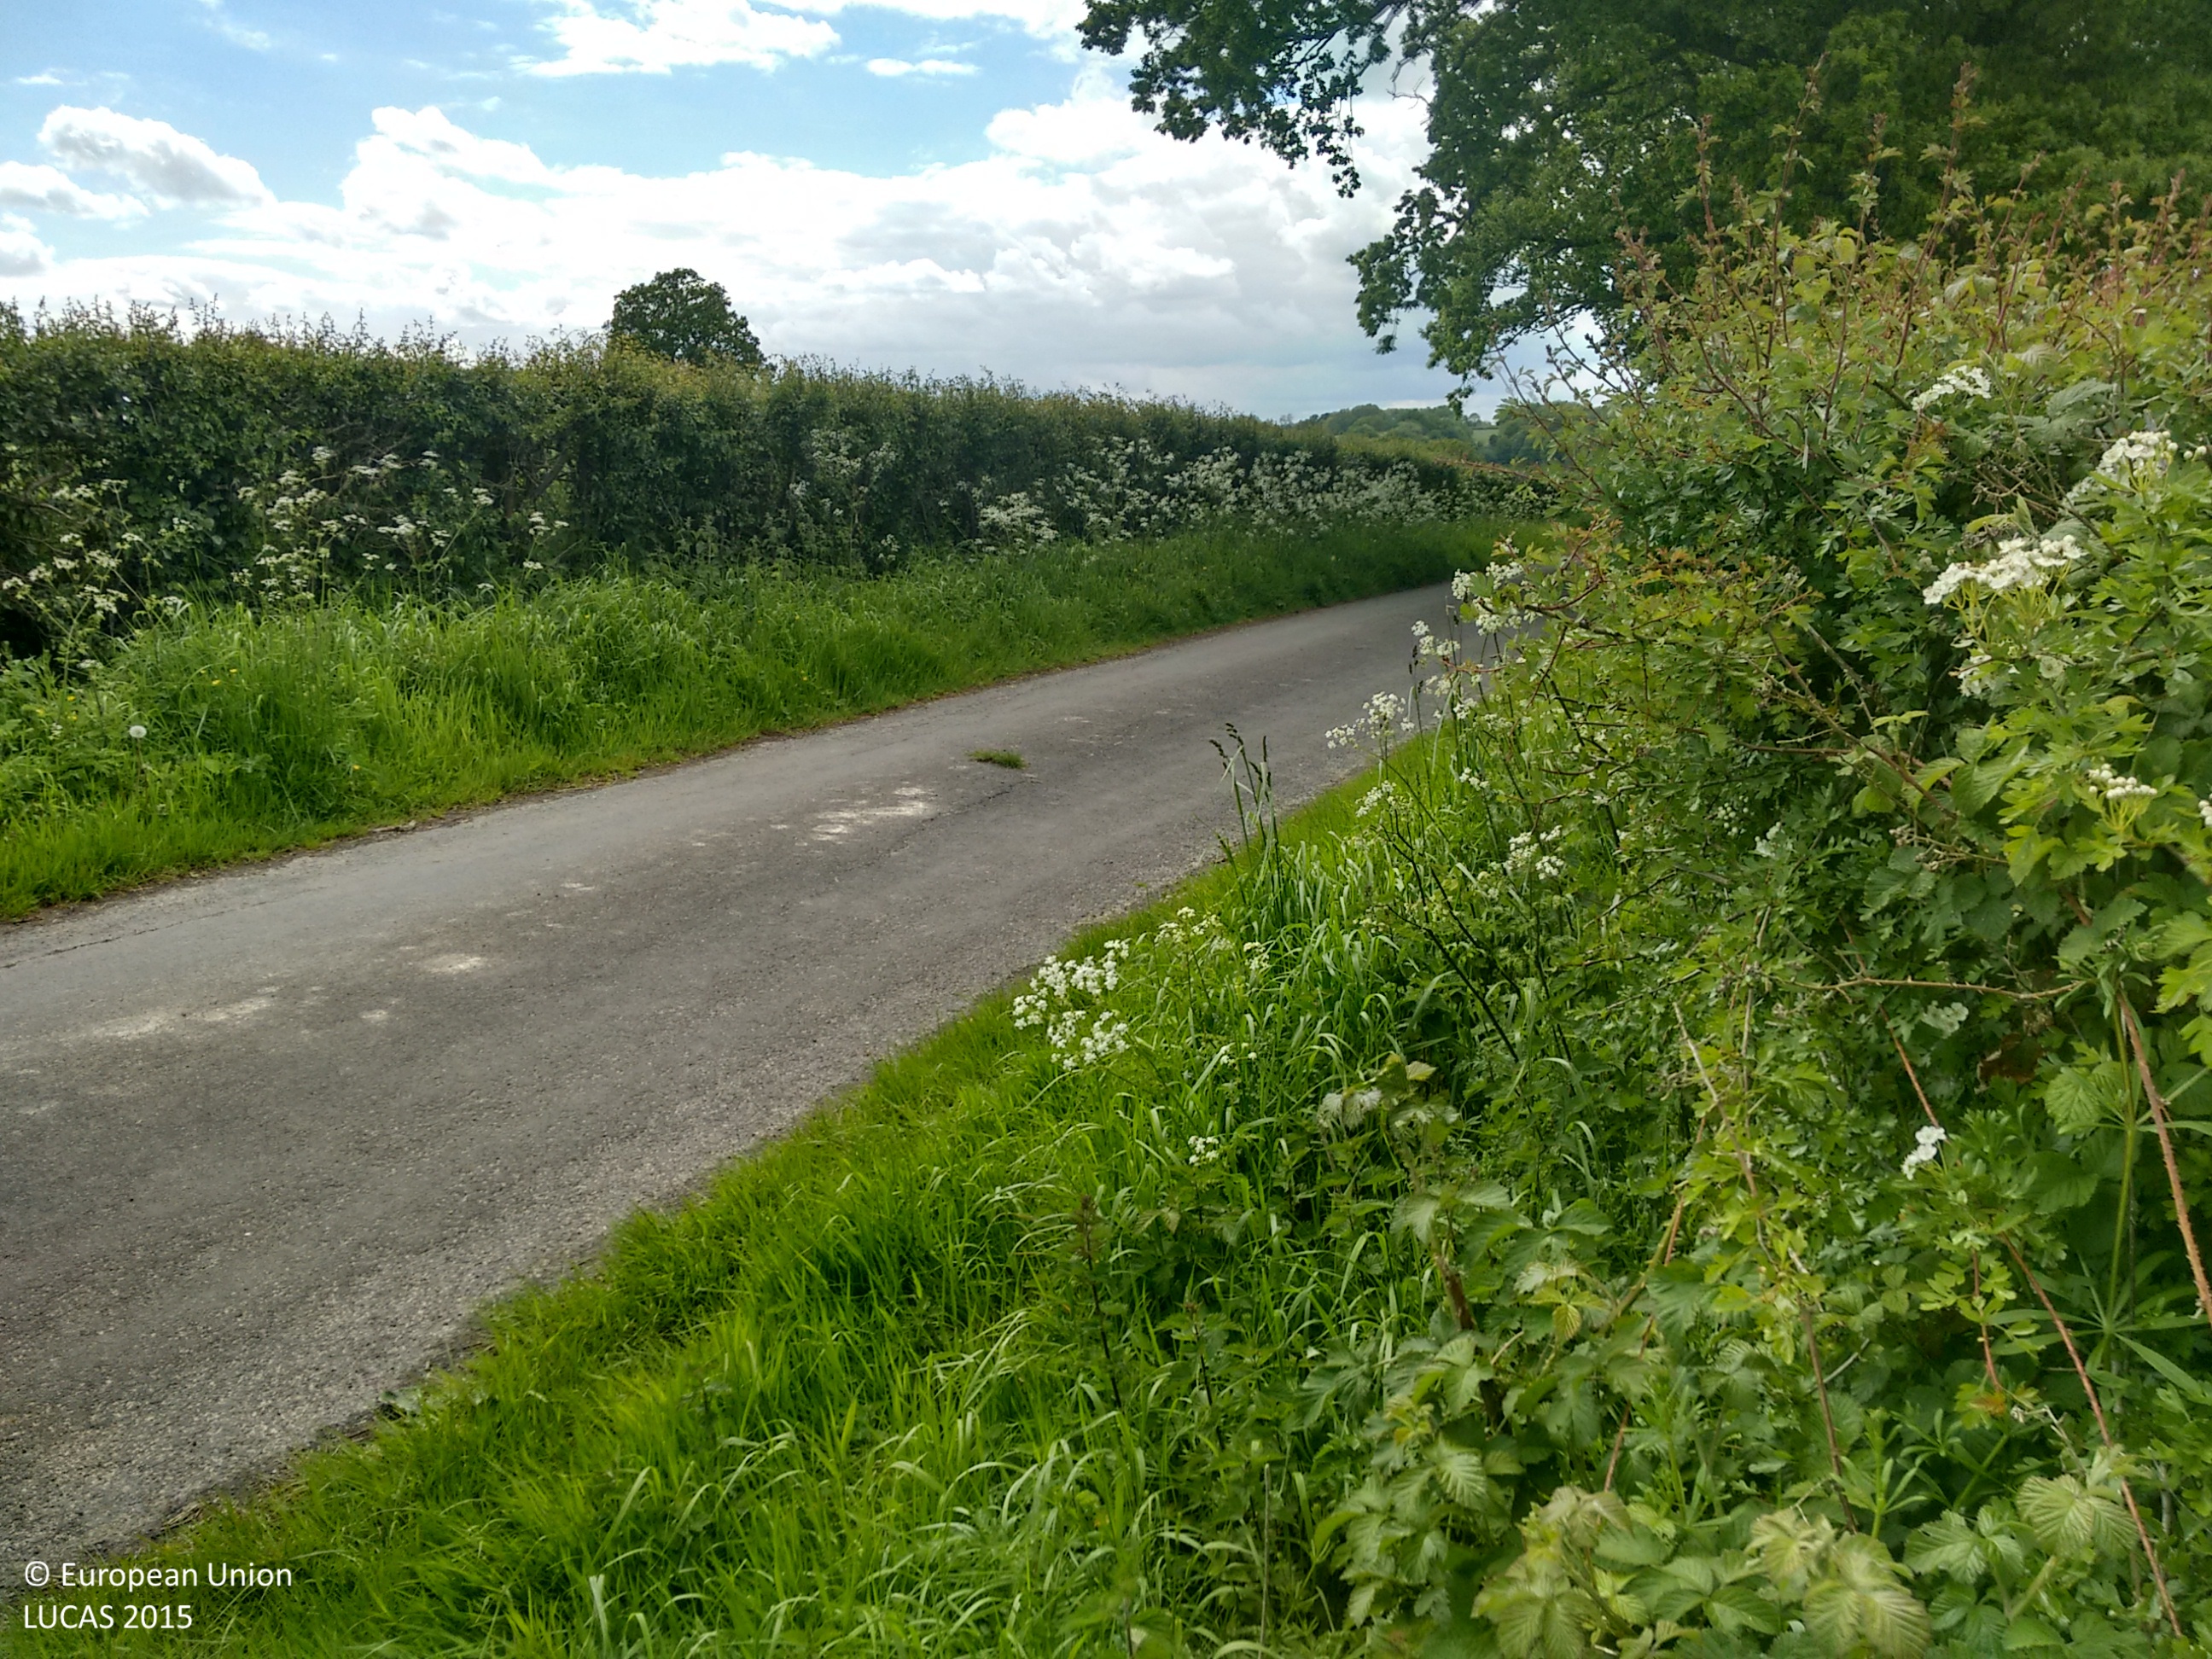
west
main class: Cropland
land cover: Dry pulses
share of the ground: 50 - 75 %
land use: Agriculture (excluding fallow land and kitchen gardens)
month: May
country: GB
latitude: 51.1514
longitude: 0.1470
